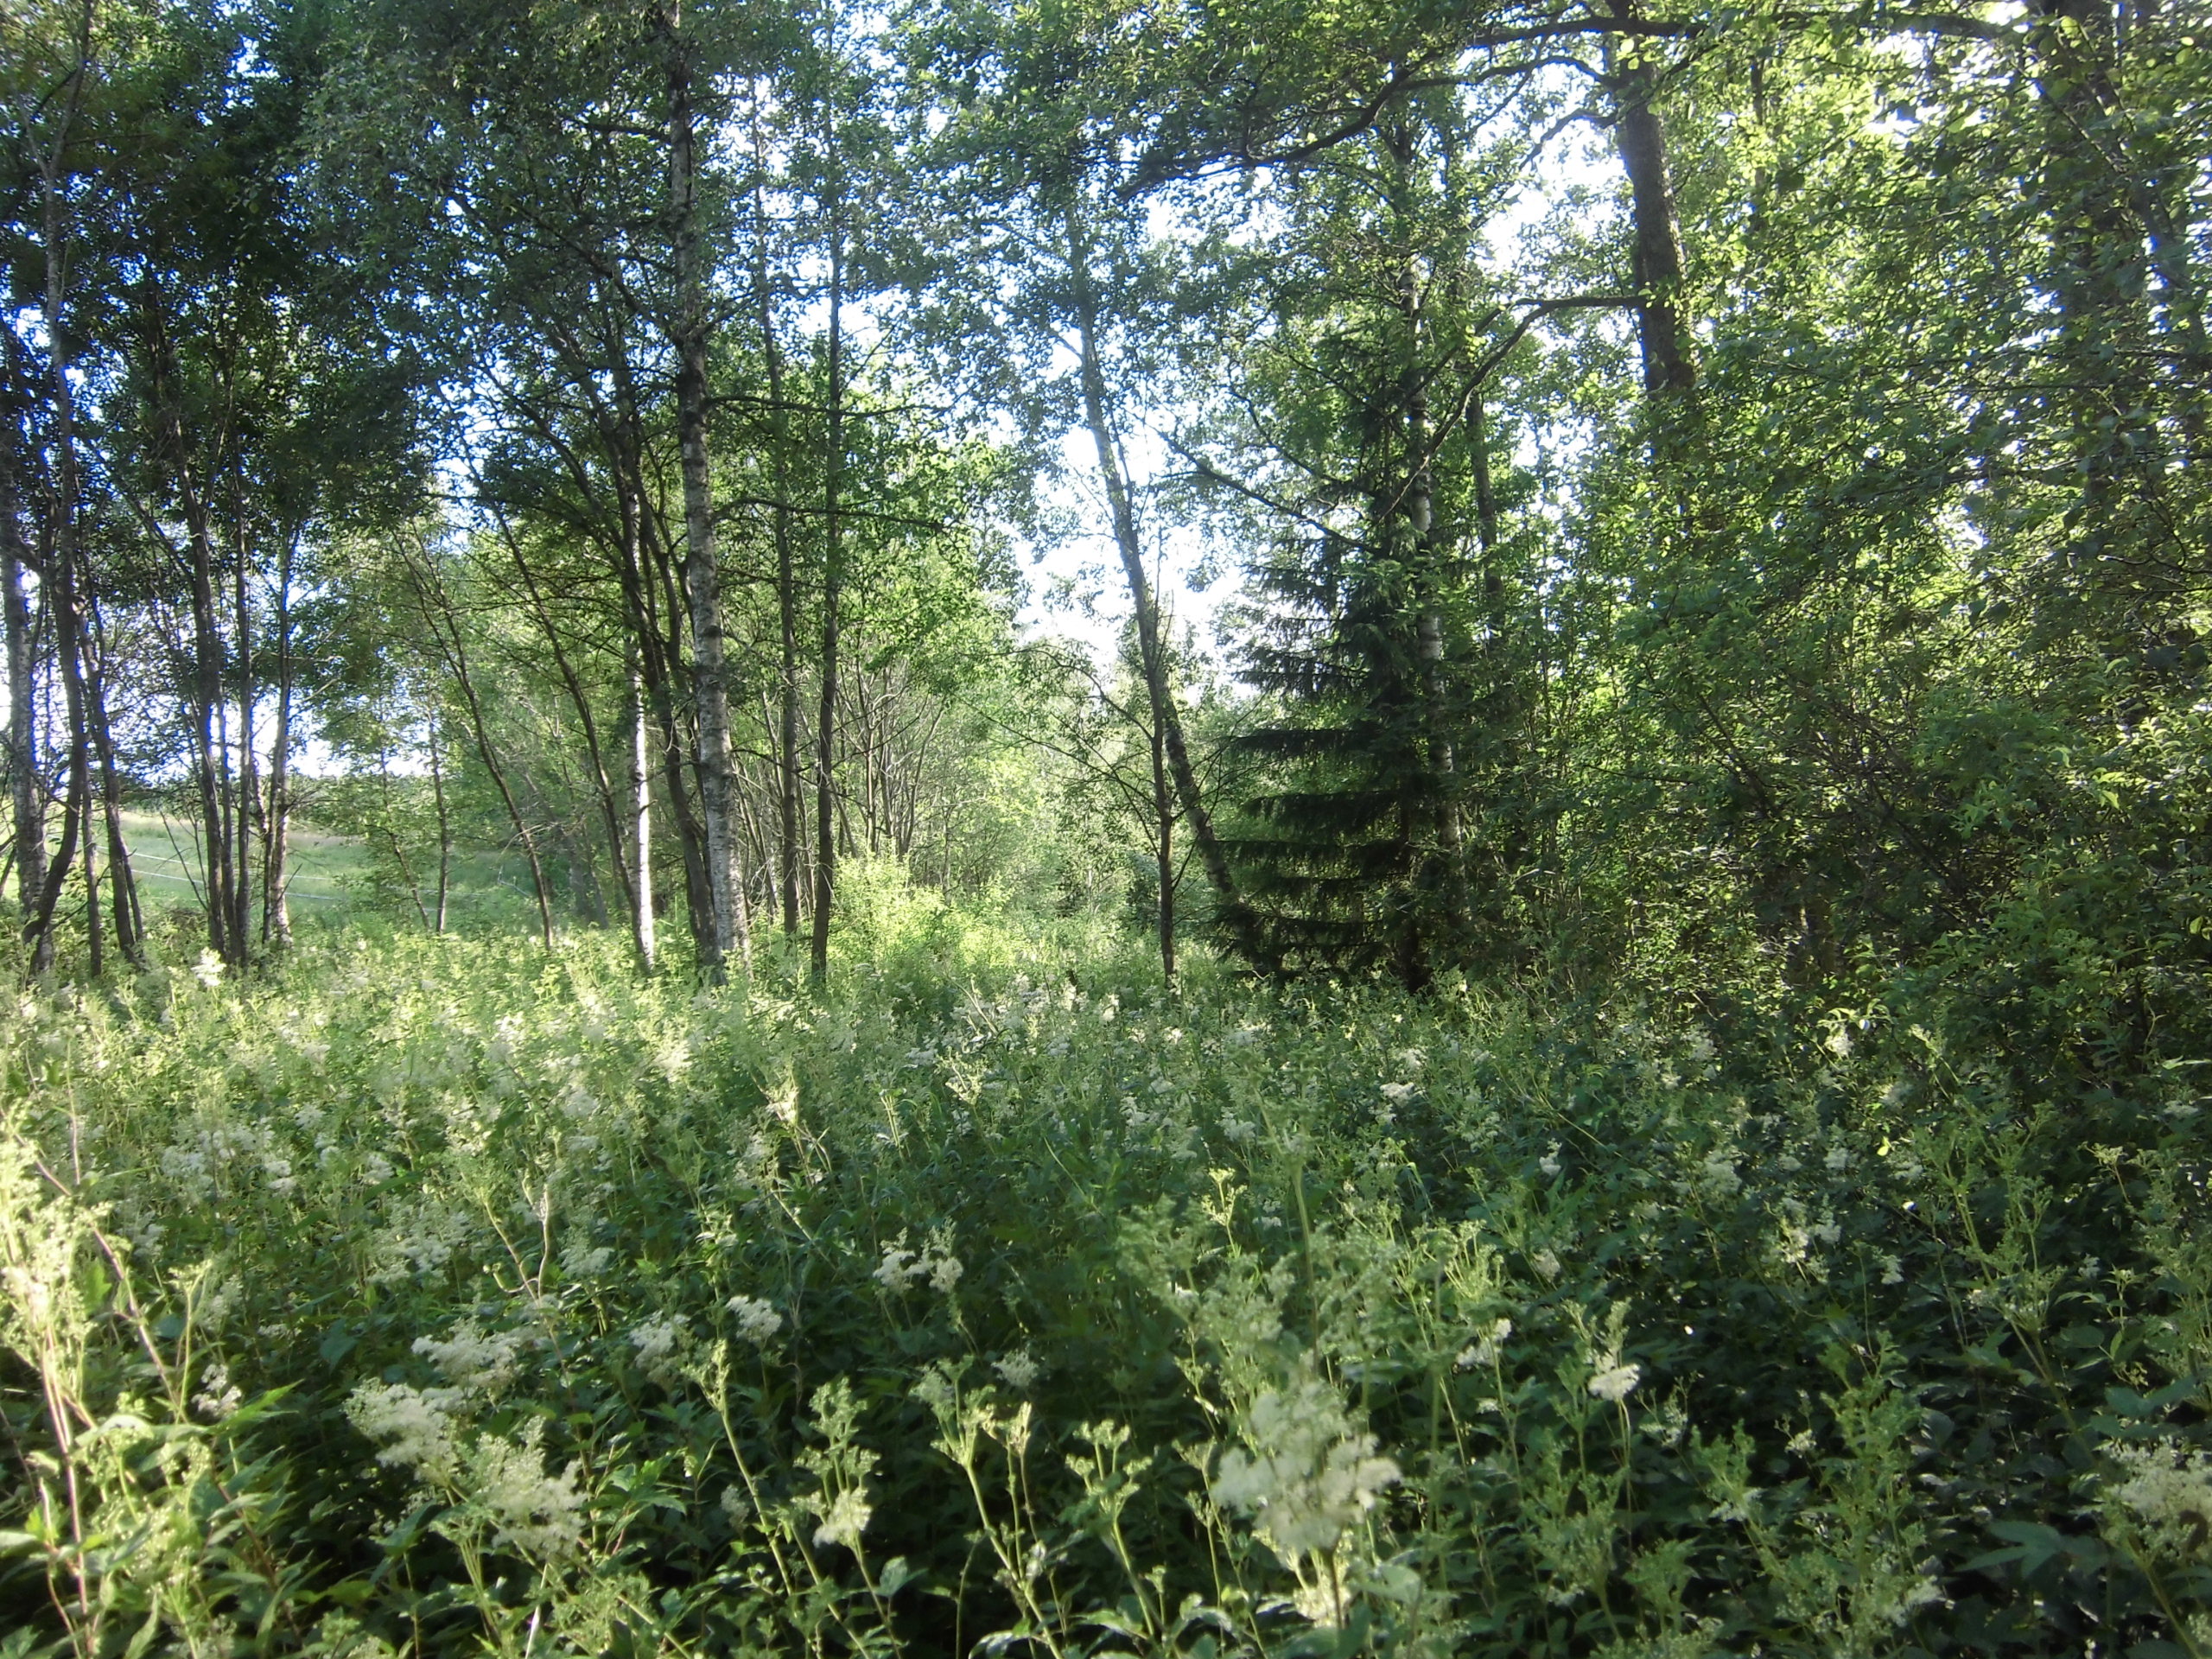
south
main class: Woodland
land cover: Broadleaved woodland
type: boreal forest
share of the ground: 50 - 75 %
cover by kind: broadleaved forest trees 60 %, herbaceous plants 35 %, shrubs 5 %
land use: Forestry
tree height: > 5 m
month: July
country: SE
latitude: 57.3824
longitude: 15.1363
